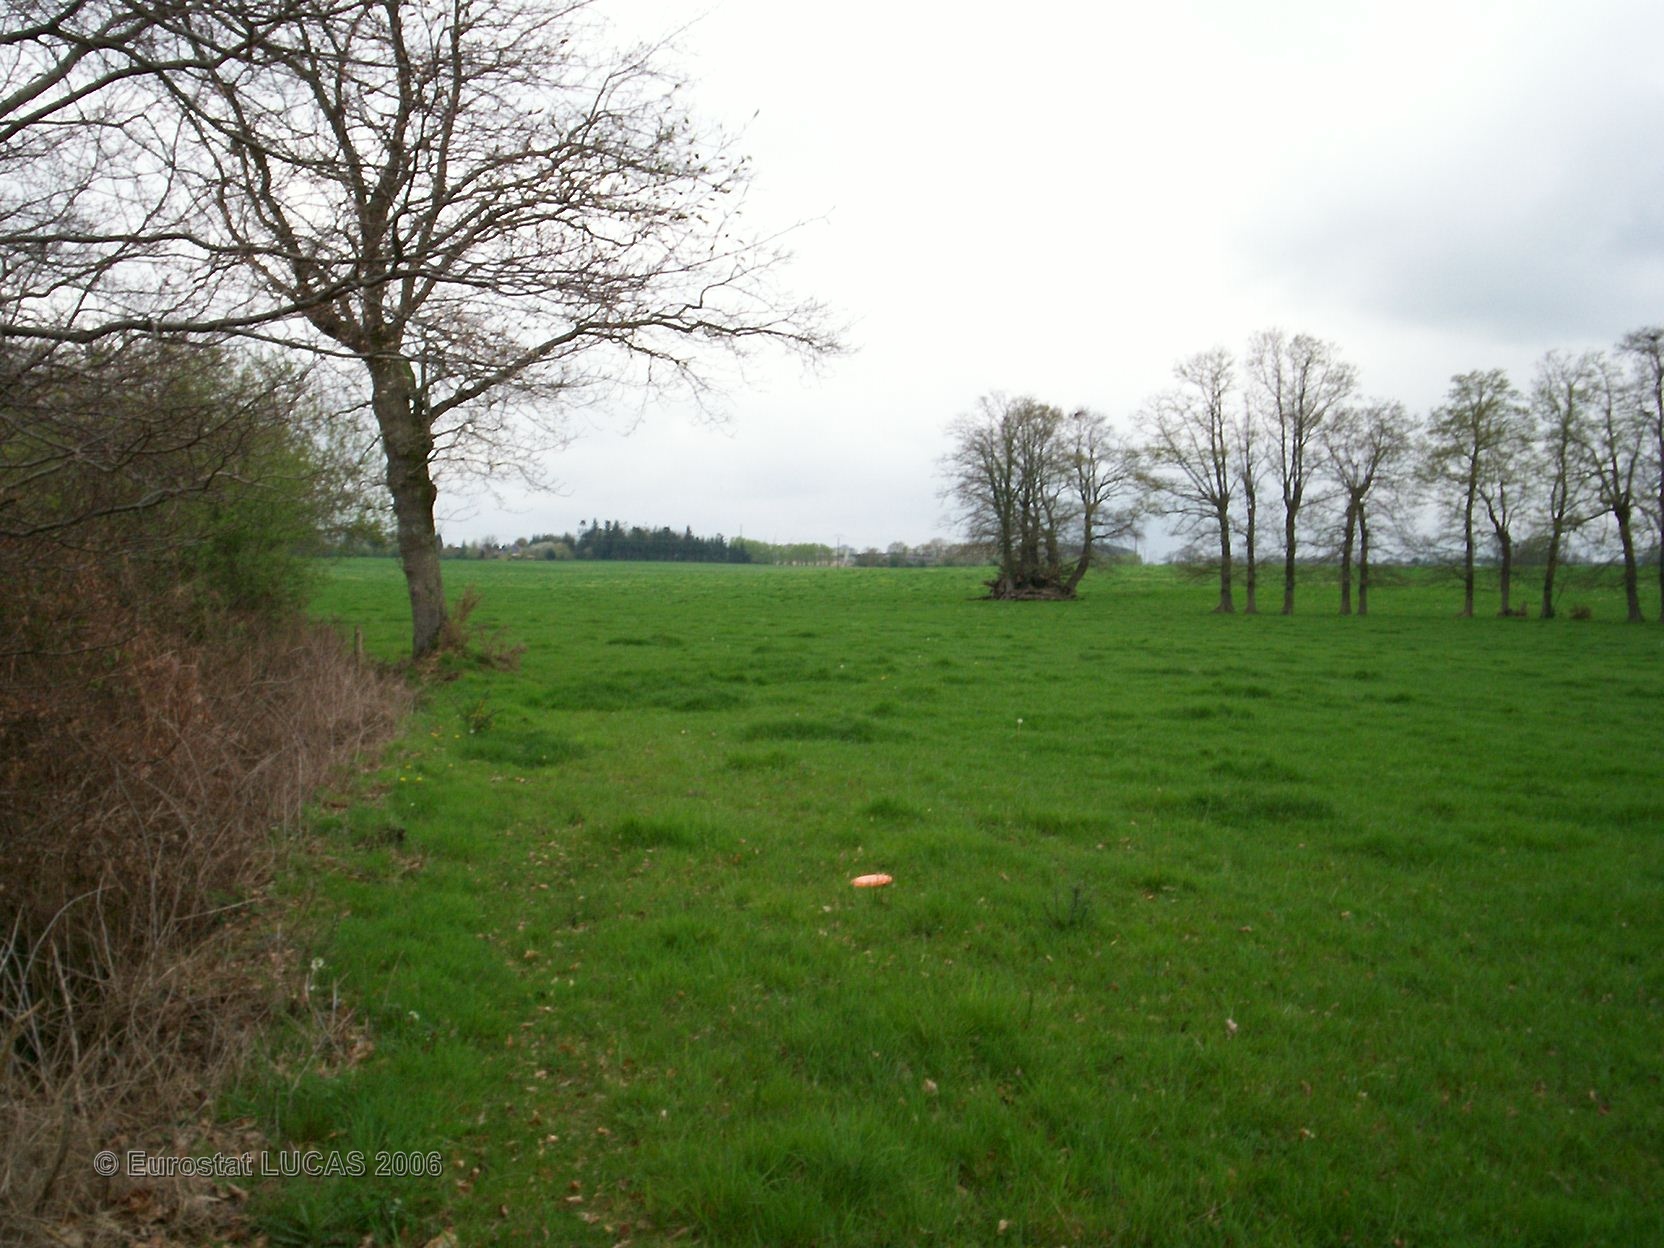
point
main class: Grassland
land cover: Grassland without tree/shrub cover
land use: Agriculture (excluding fallow land and kitchen gardens)
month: April
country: FR
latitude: 48.0821
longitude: -2.4221
